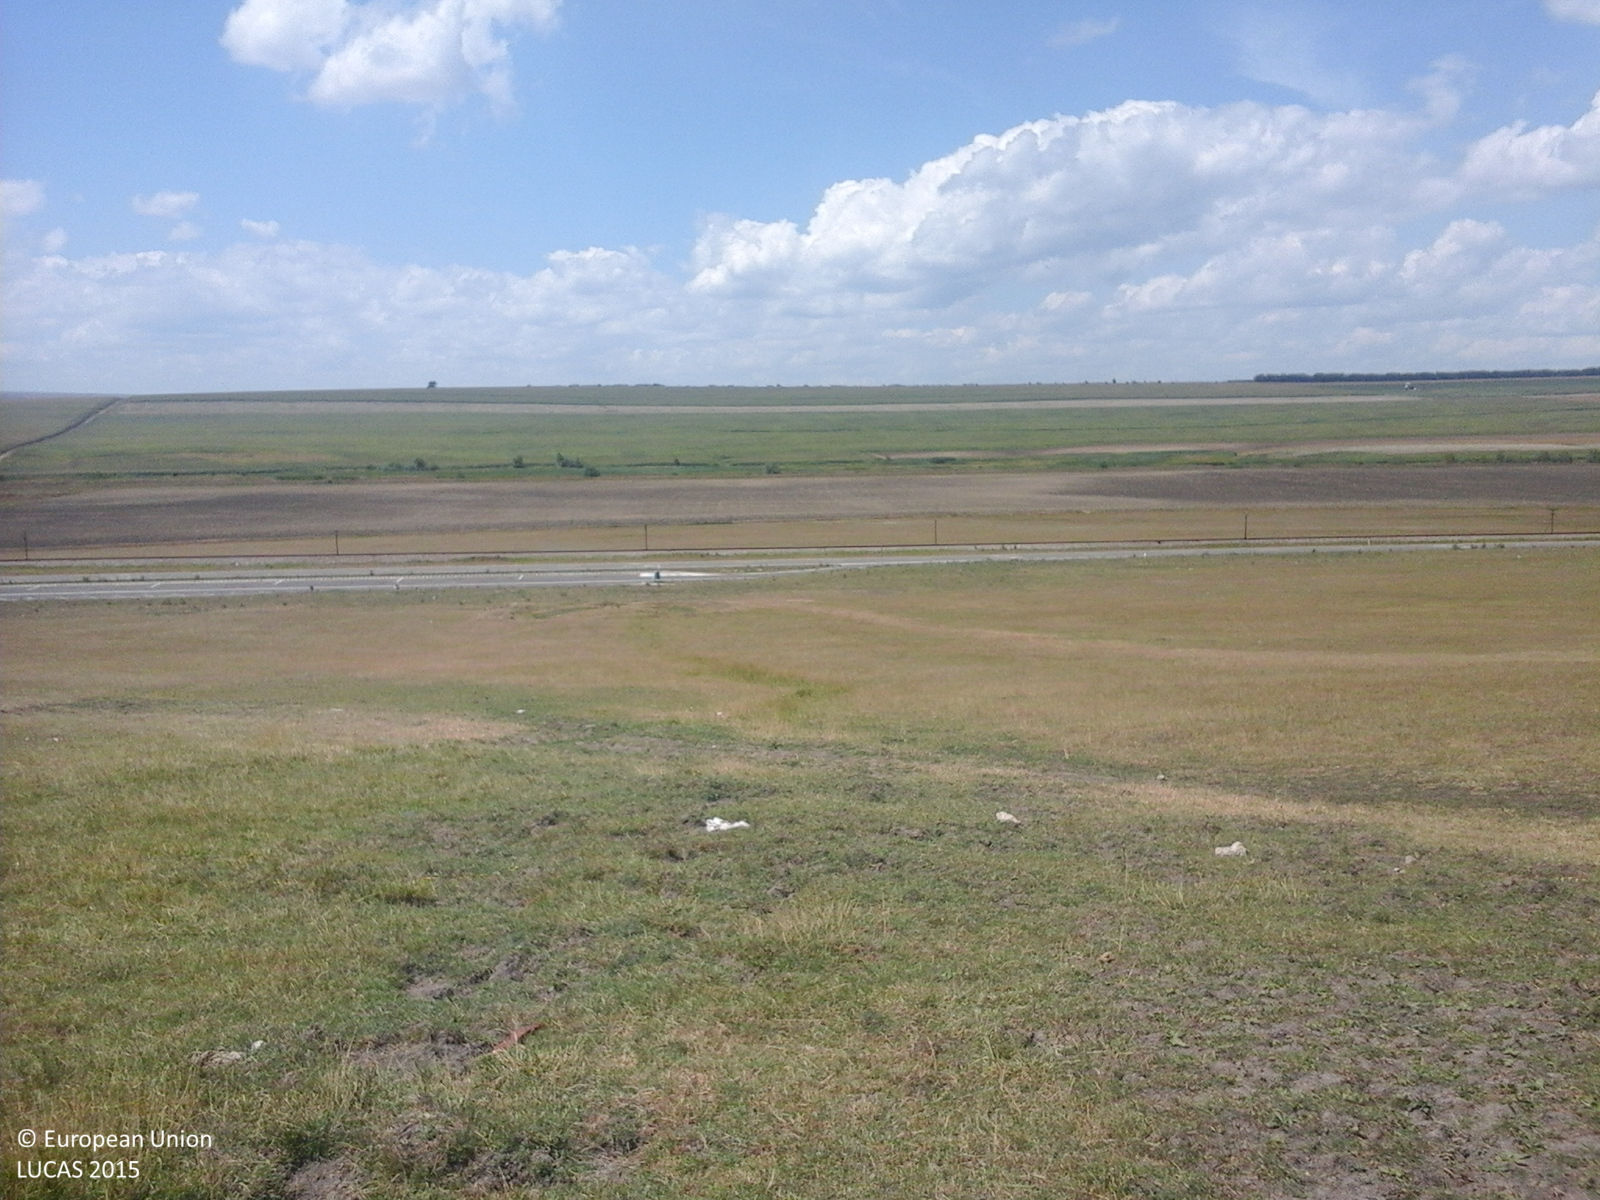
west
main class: Grassland
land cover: Grassland without tree/shrub cover
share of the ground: > 75 %
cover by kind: herbaceous plants 100 %
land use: Agriculture (excluding fallow land and kitchen gardens)
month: July
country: RO
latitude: 46.5312
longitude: 27.8398
